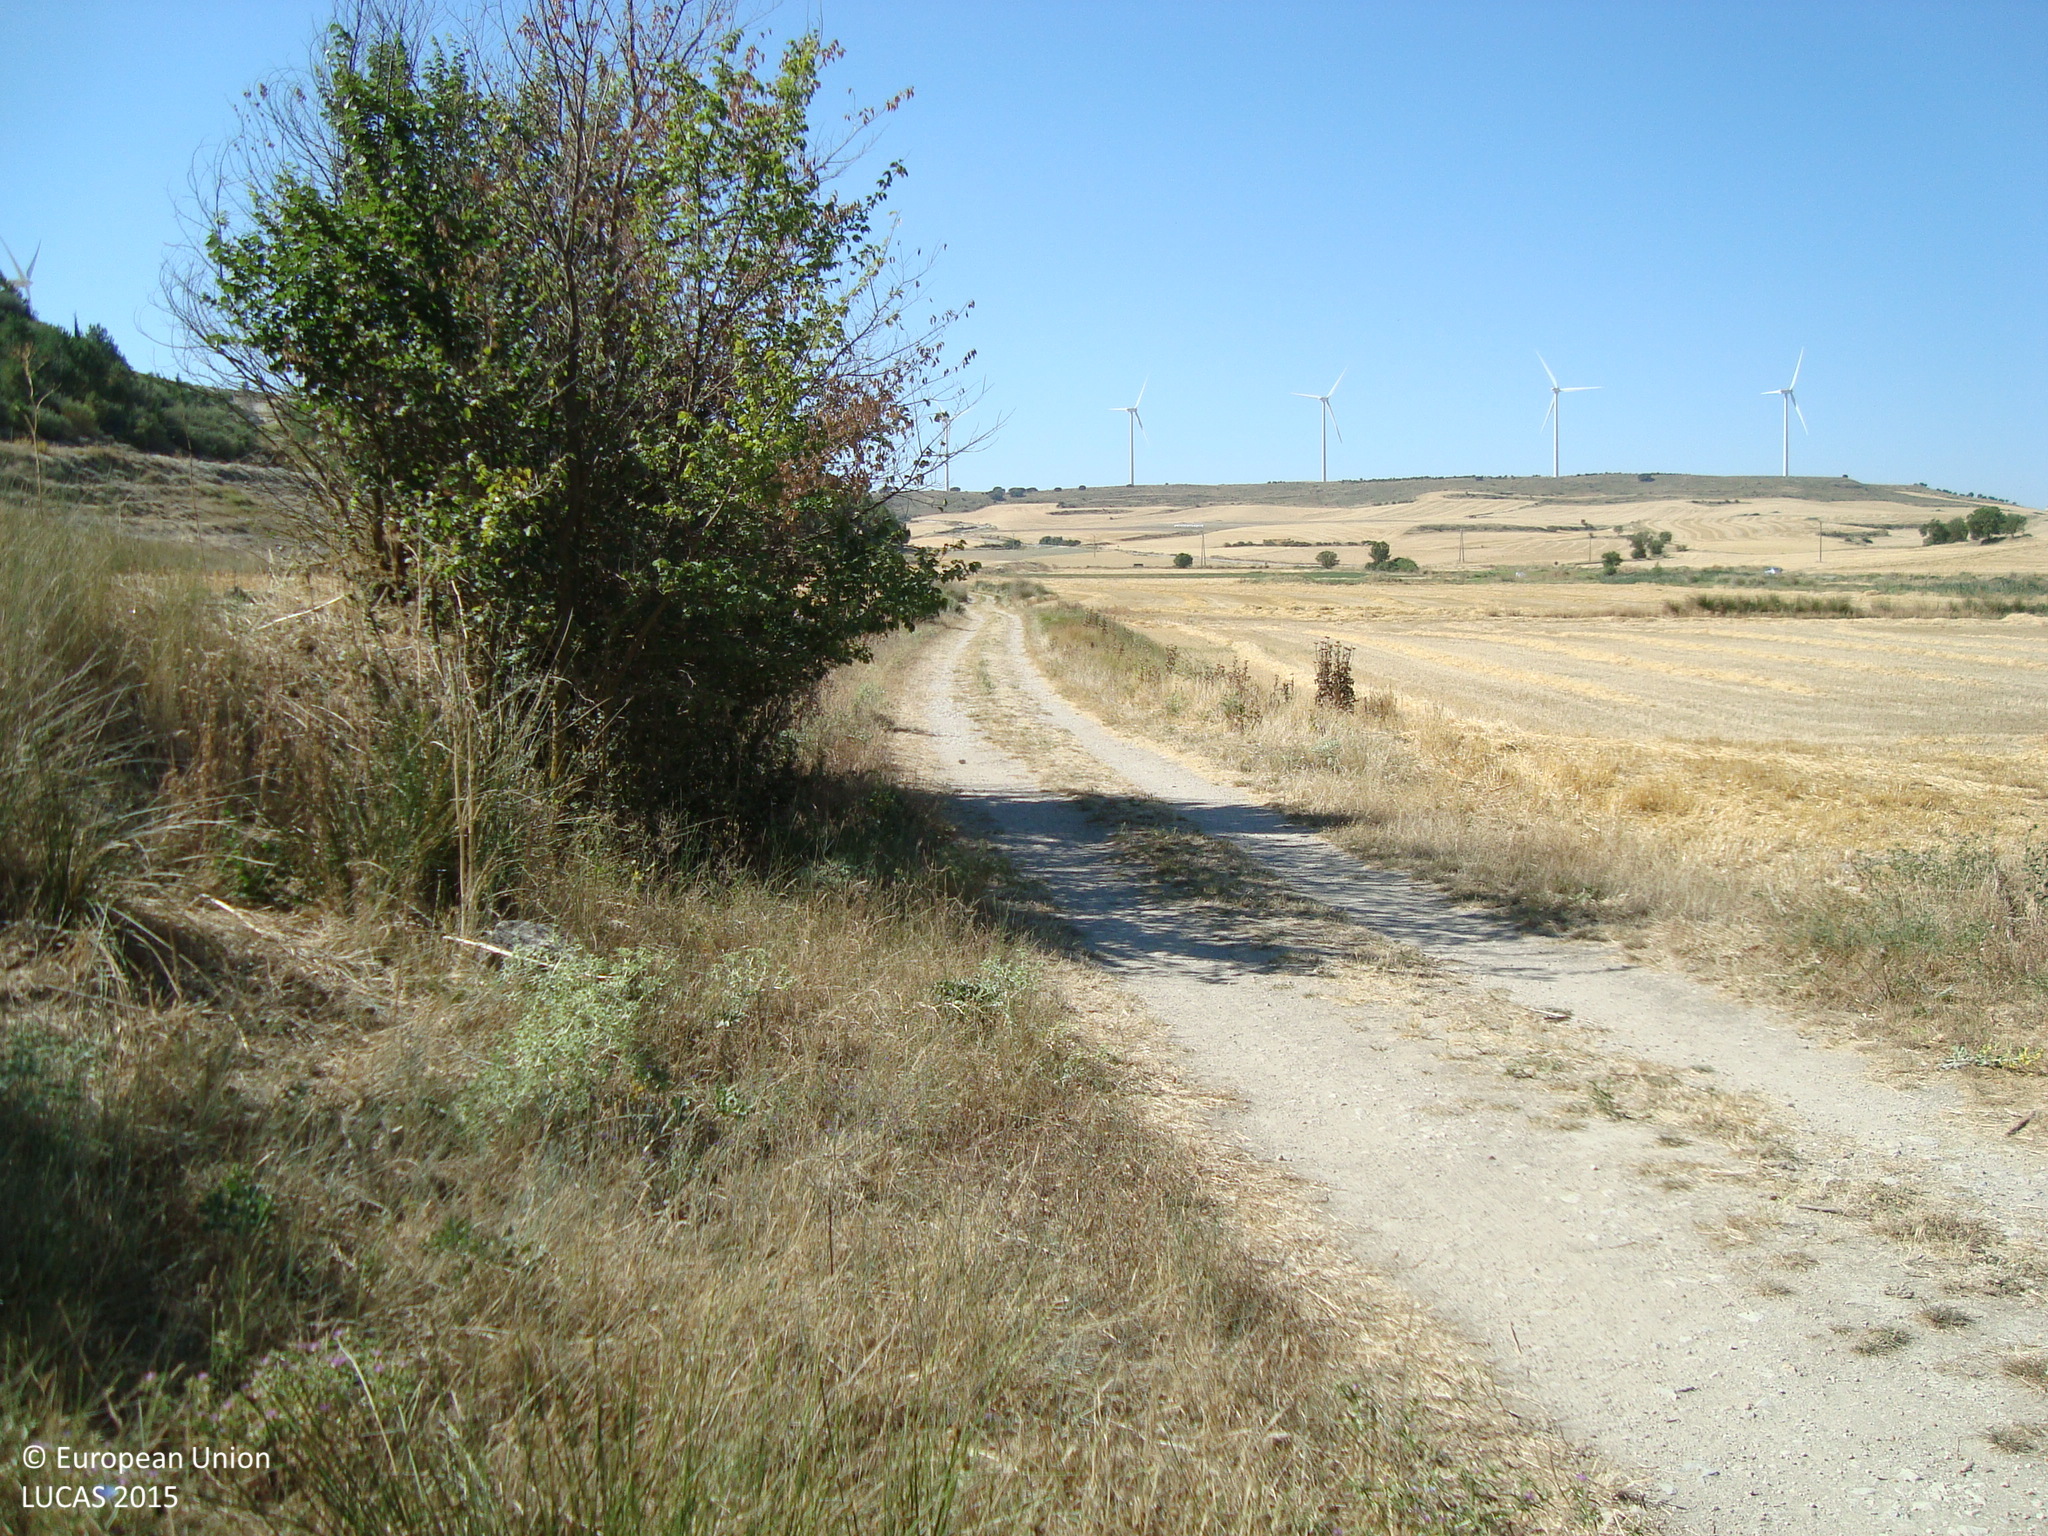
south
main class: Grassland
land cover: Grassland with sparse tree/shrub cover
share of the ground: 25 - 50 %
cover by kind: herbaceous plants 40 %, unconsolidated bare surface 10 %, broadleaved forest trees 5 %, shrubs 5 %
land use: Semi-natural and natural areas not in use
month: July
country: ES
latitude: 41.9854
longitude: -4.2719
